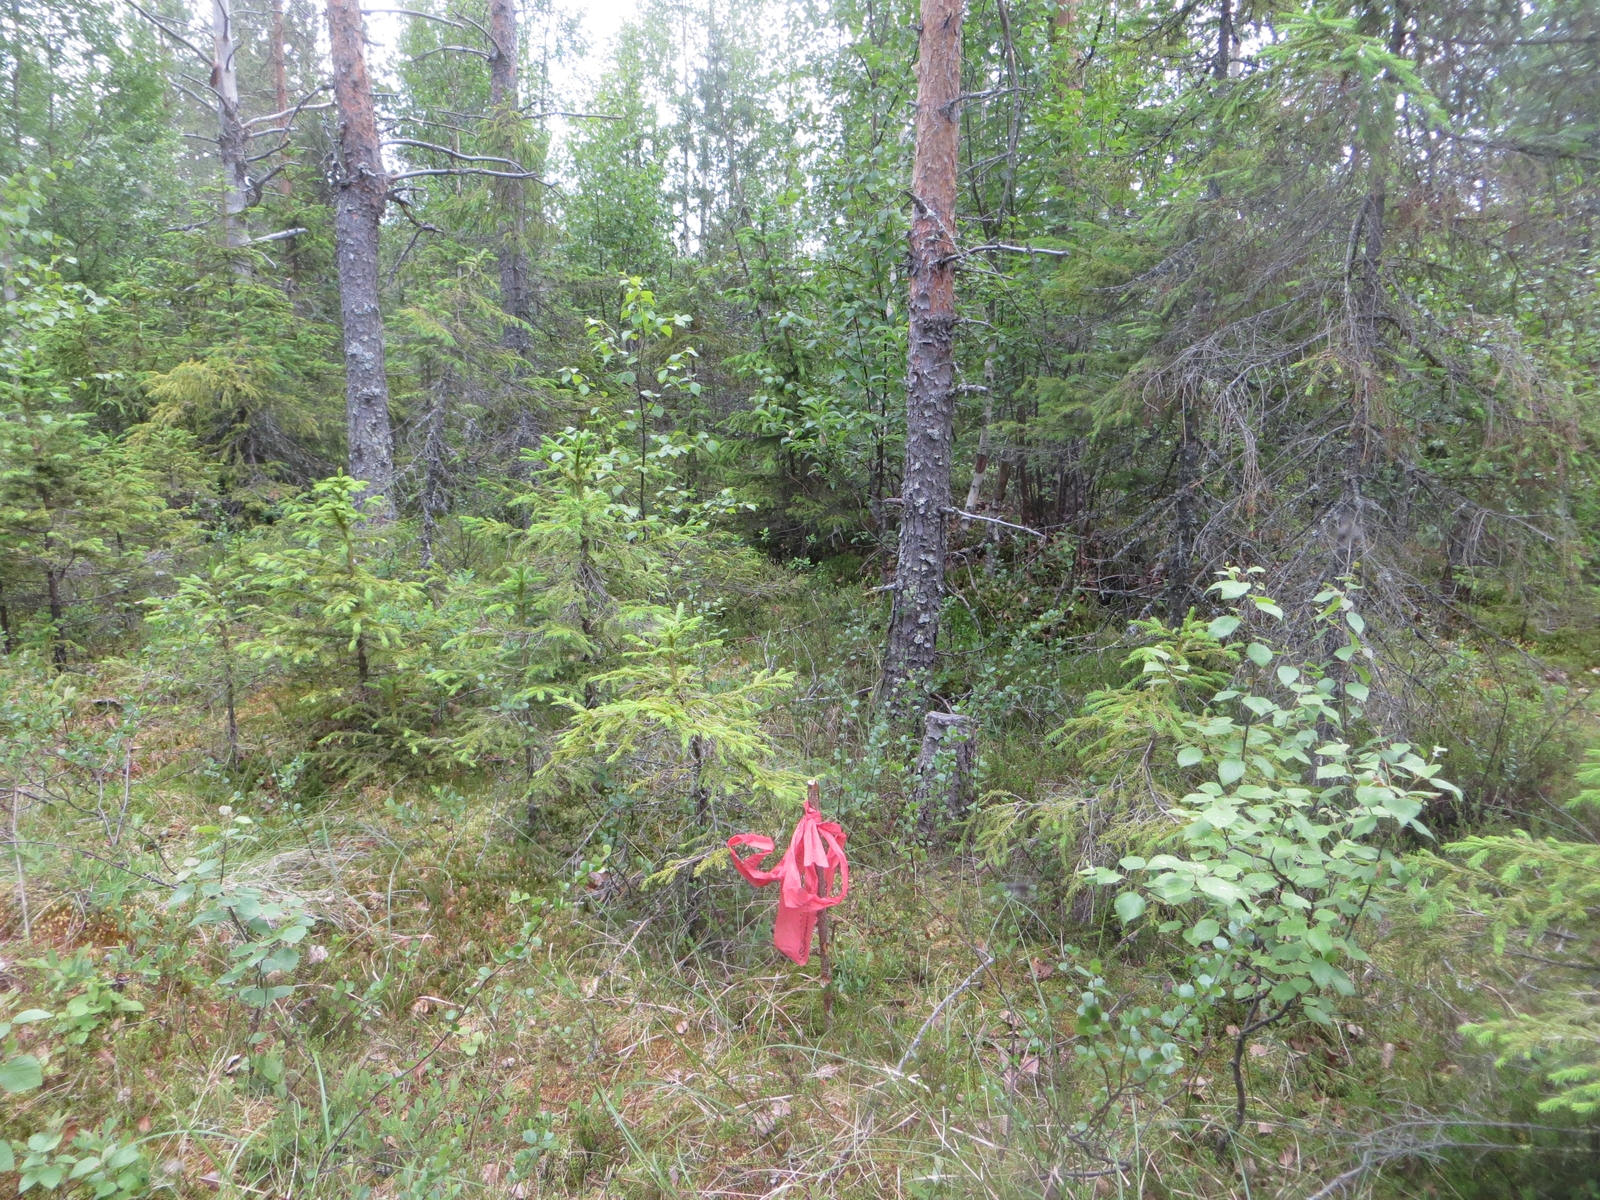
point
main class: Woodland
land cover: Pine dominated mixed woodland
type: boreal forest
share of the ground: 50 - 75 %
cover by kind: coniferous forest trees 40 %, shrubs 40 %, broadleaved forest trees 20 %
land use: Forestry
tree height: > 5 m
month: July
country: FI
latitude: 65.4633
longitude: 25.8618
